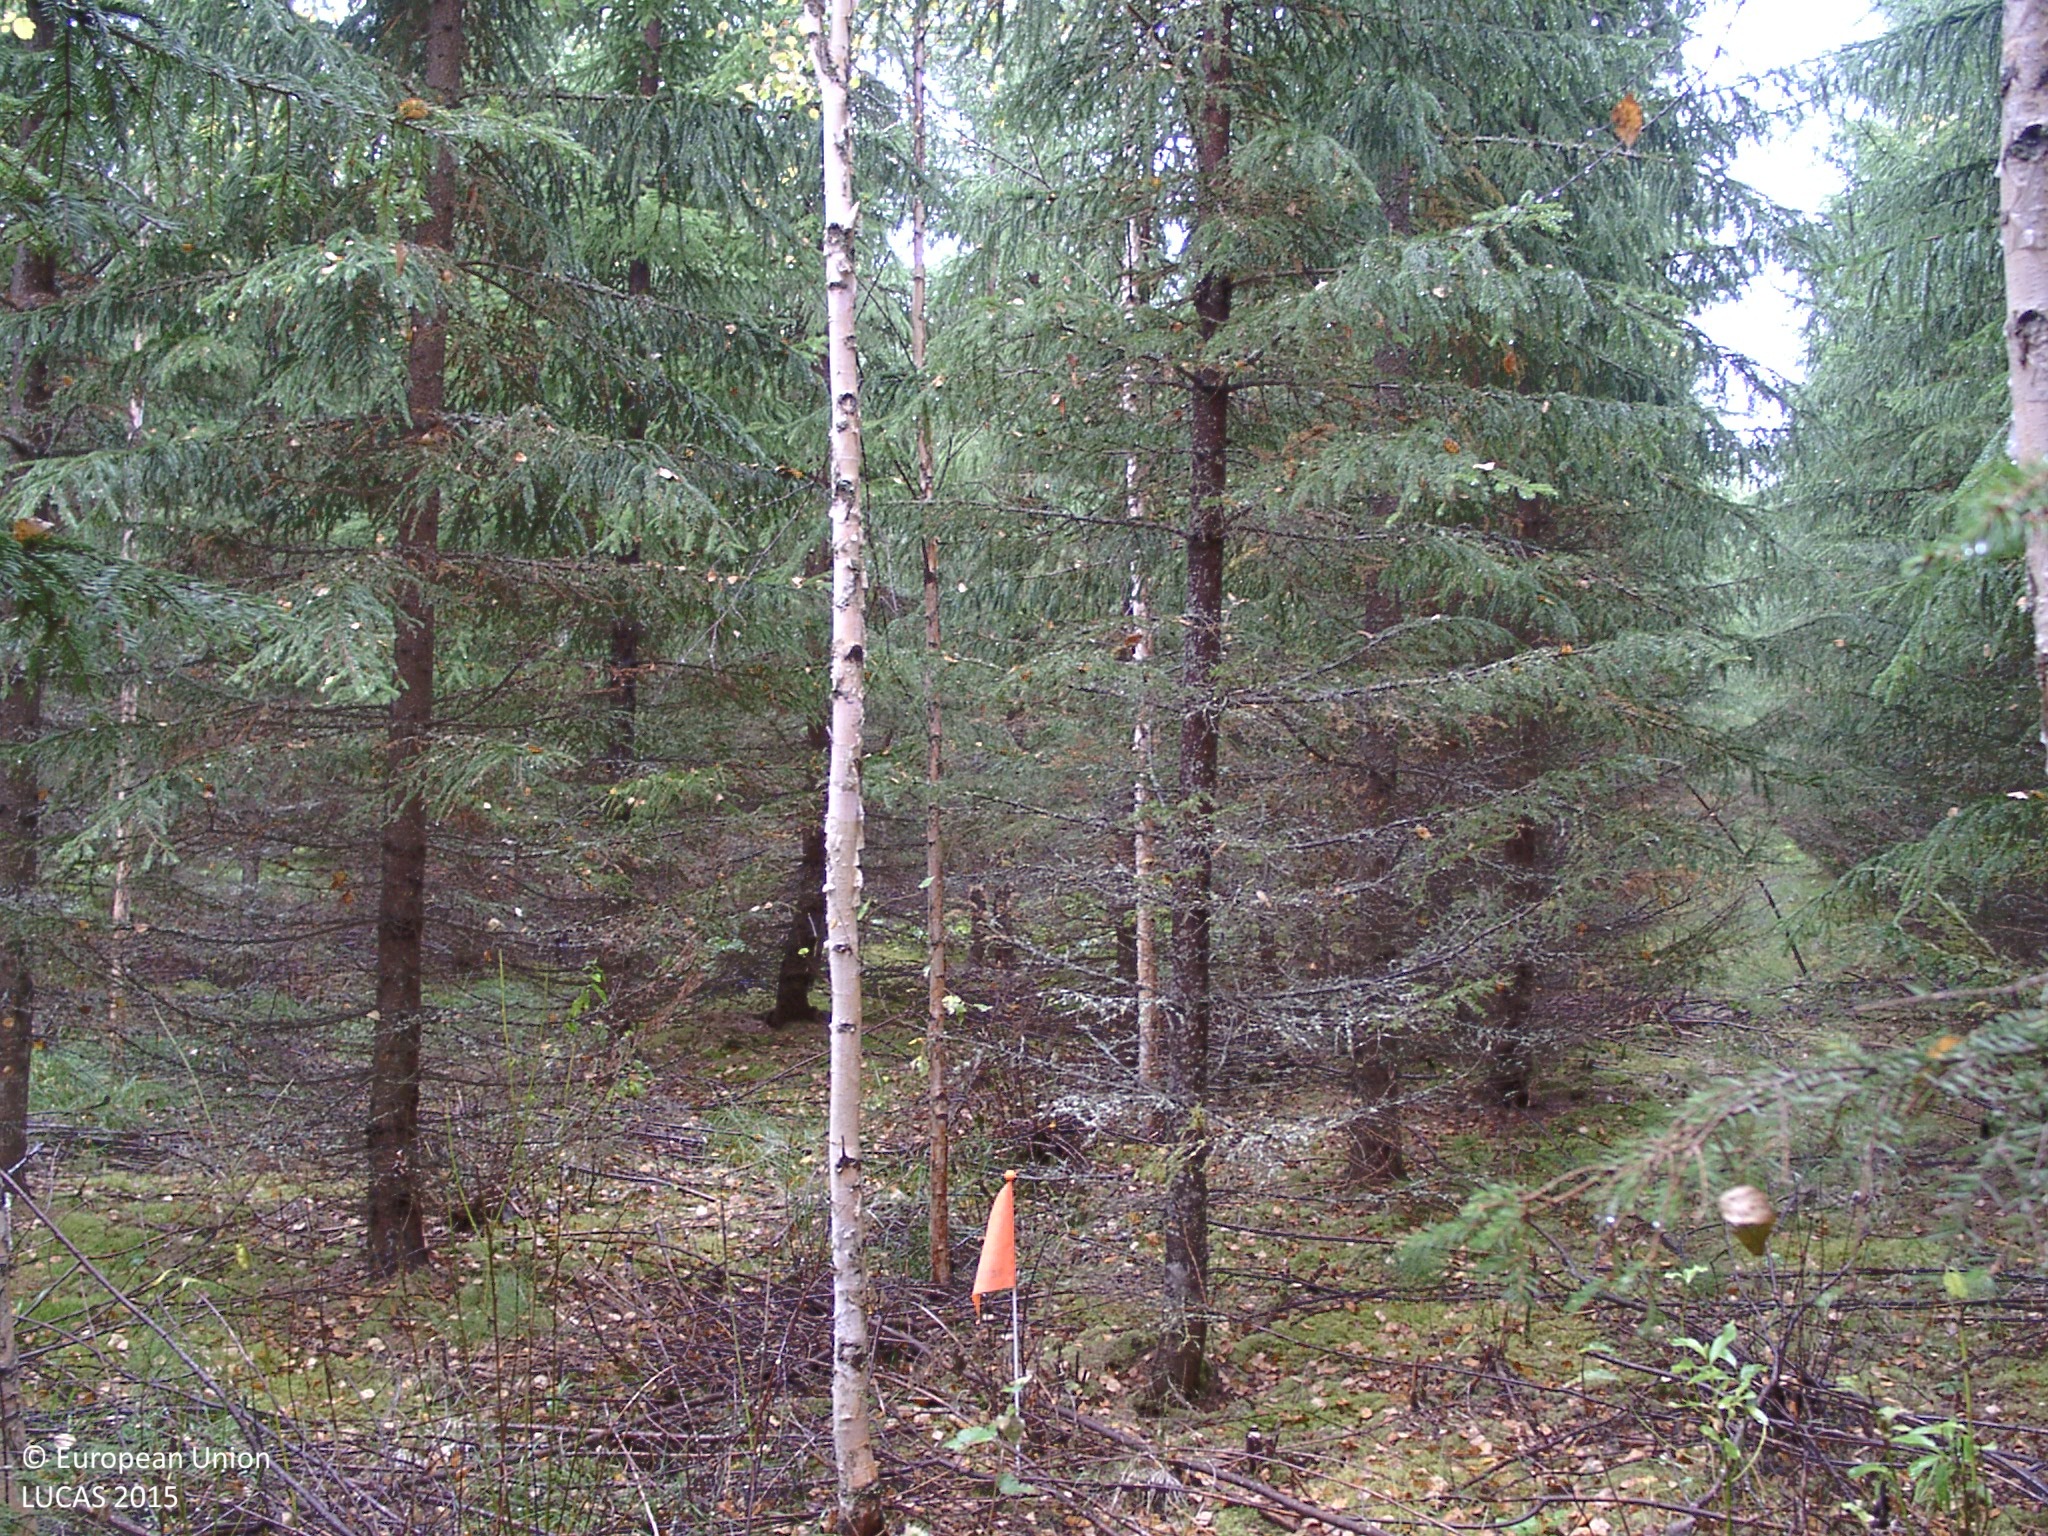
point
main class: Woodland
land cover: Spruce dominated mixed woodland
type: boreal forest
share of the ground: > 75 %
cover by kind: coniferous forest trees 60 %, broadleaved forest trees 25 %, herbaceous plants 5 %, lichens and mosses 5 %
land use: Forestry
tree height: > 5 m
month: September
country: FI
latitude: 62.6211
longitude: 25.6090
